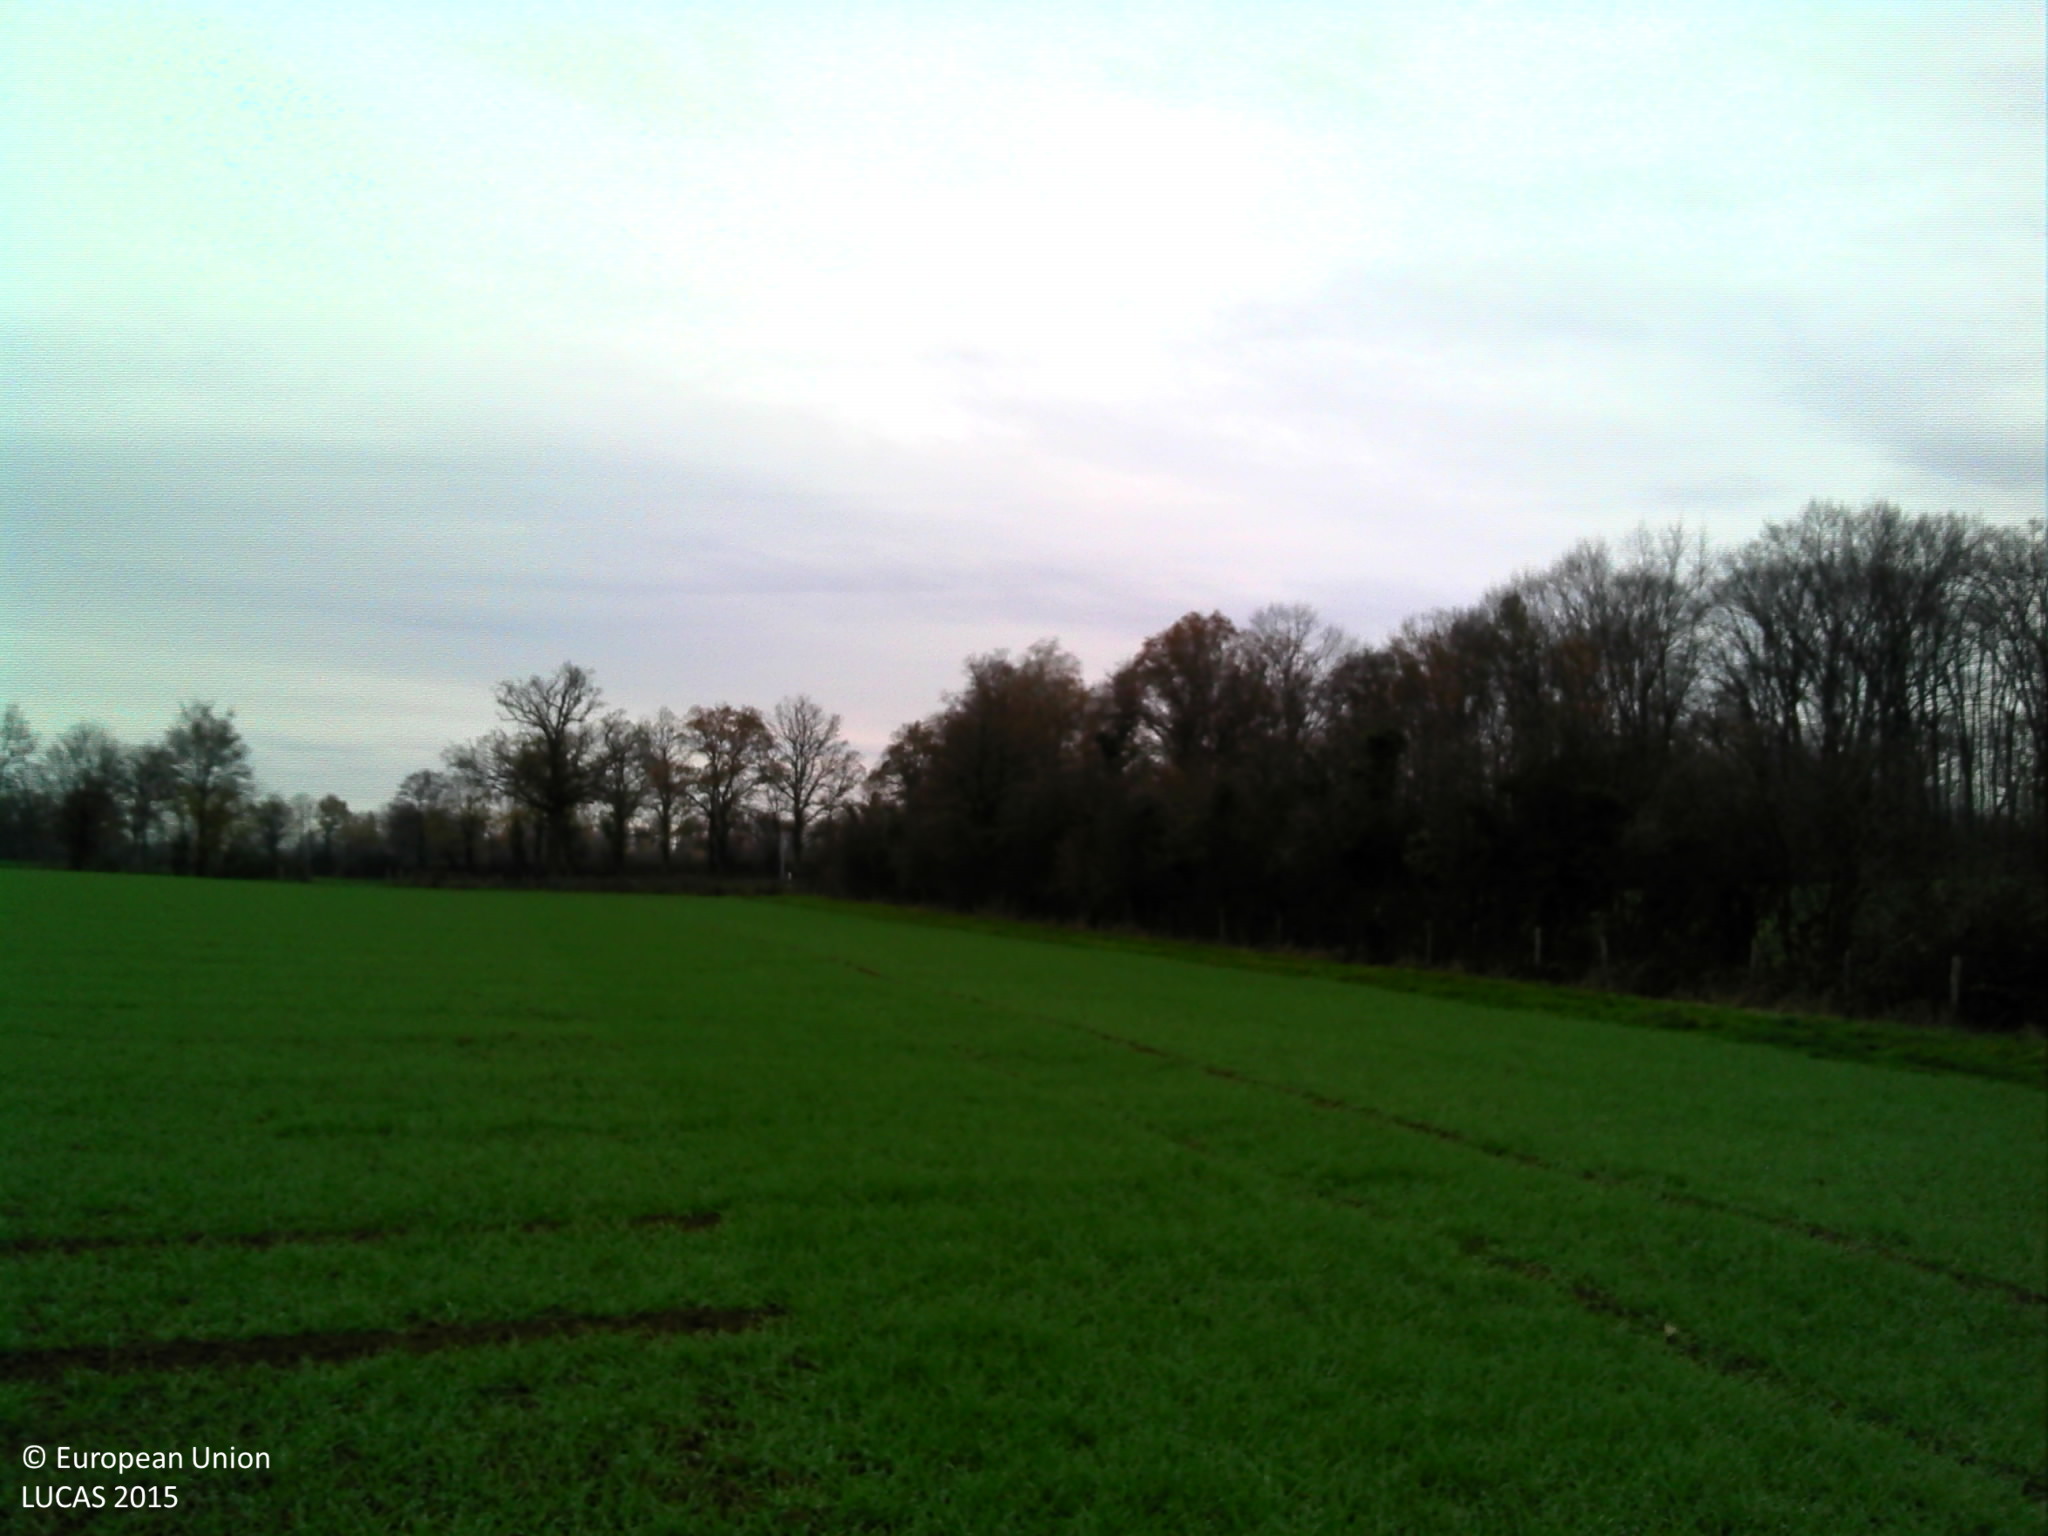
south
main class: Cropland
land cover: Common wheat
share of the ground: > 75 %
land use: Agriculture (excluding fallow land and kitchen gardens)
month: December
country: FR
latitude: 46.1329
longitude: 5.1493
